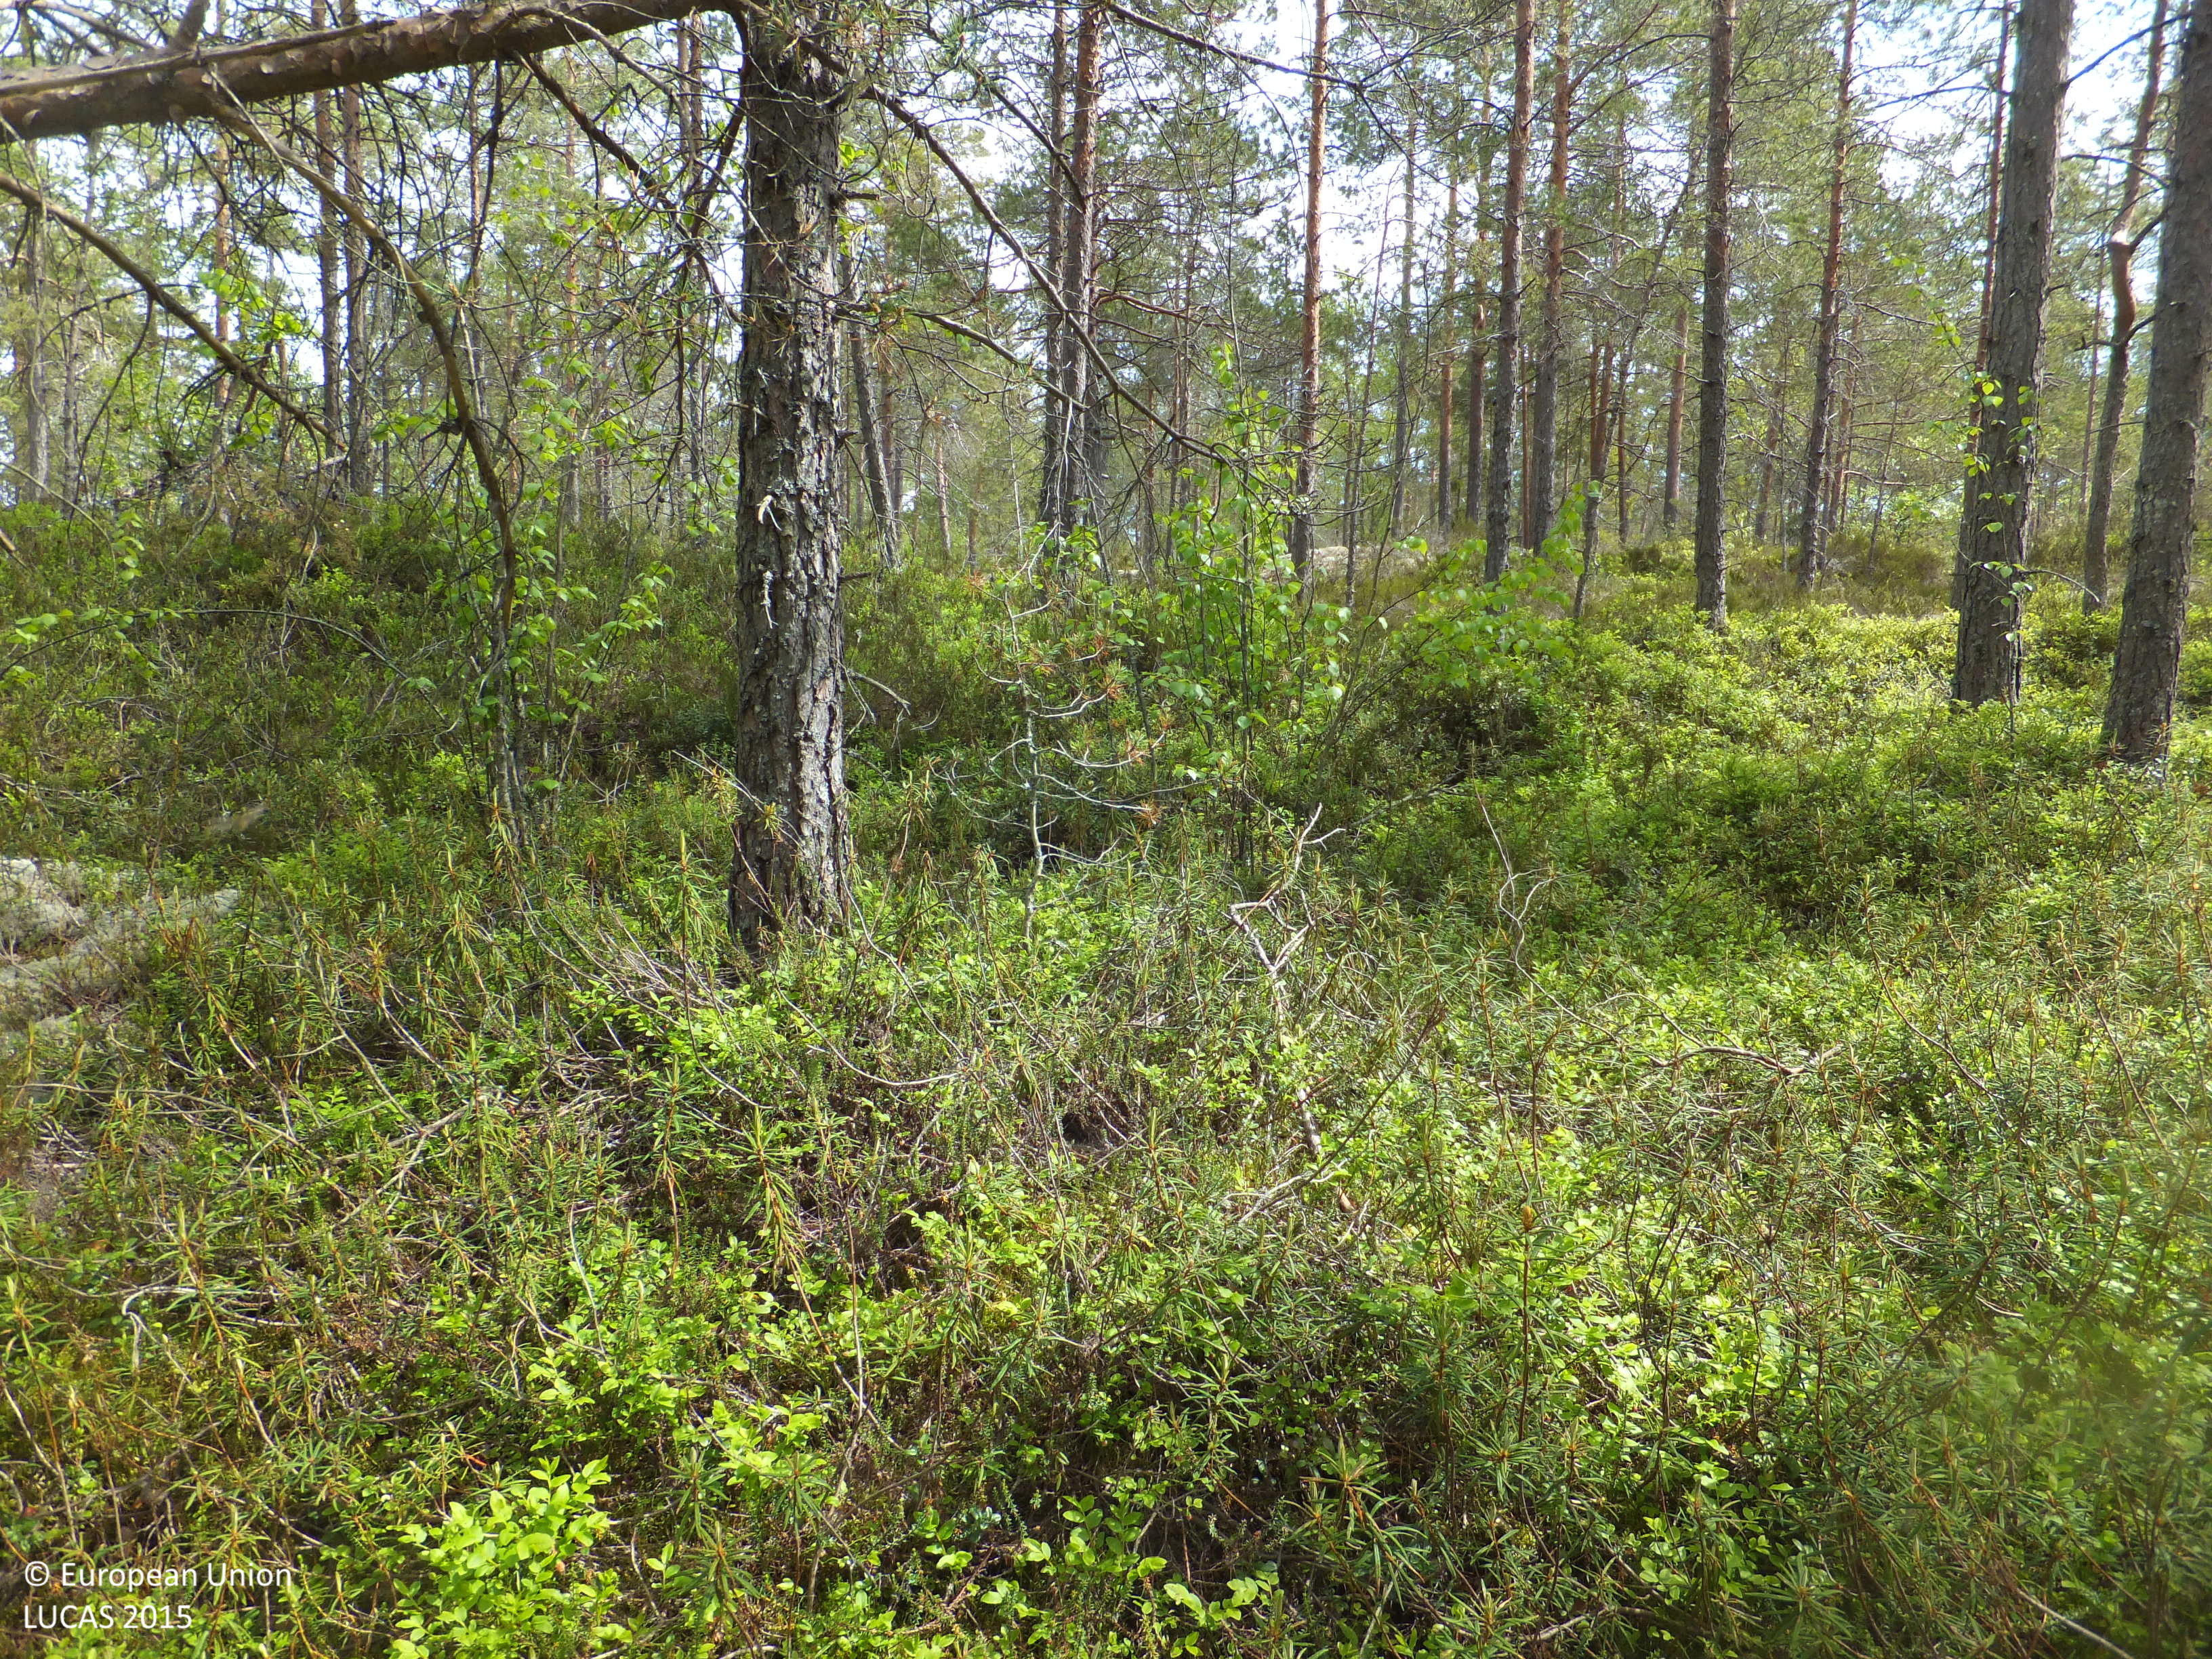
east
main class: Woodland
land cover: Pine dominated coniferous woodland
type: boreal forest
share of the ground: > 75 %
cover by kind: coniferous forest trees 80 %, shrubs 15 %, lichens and mosses 5 %
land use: Forestry
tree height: > 5 m
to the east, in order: Pine dominated coniferous woodland
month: June
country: FI
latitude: 63.4421
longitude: 22.2940
